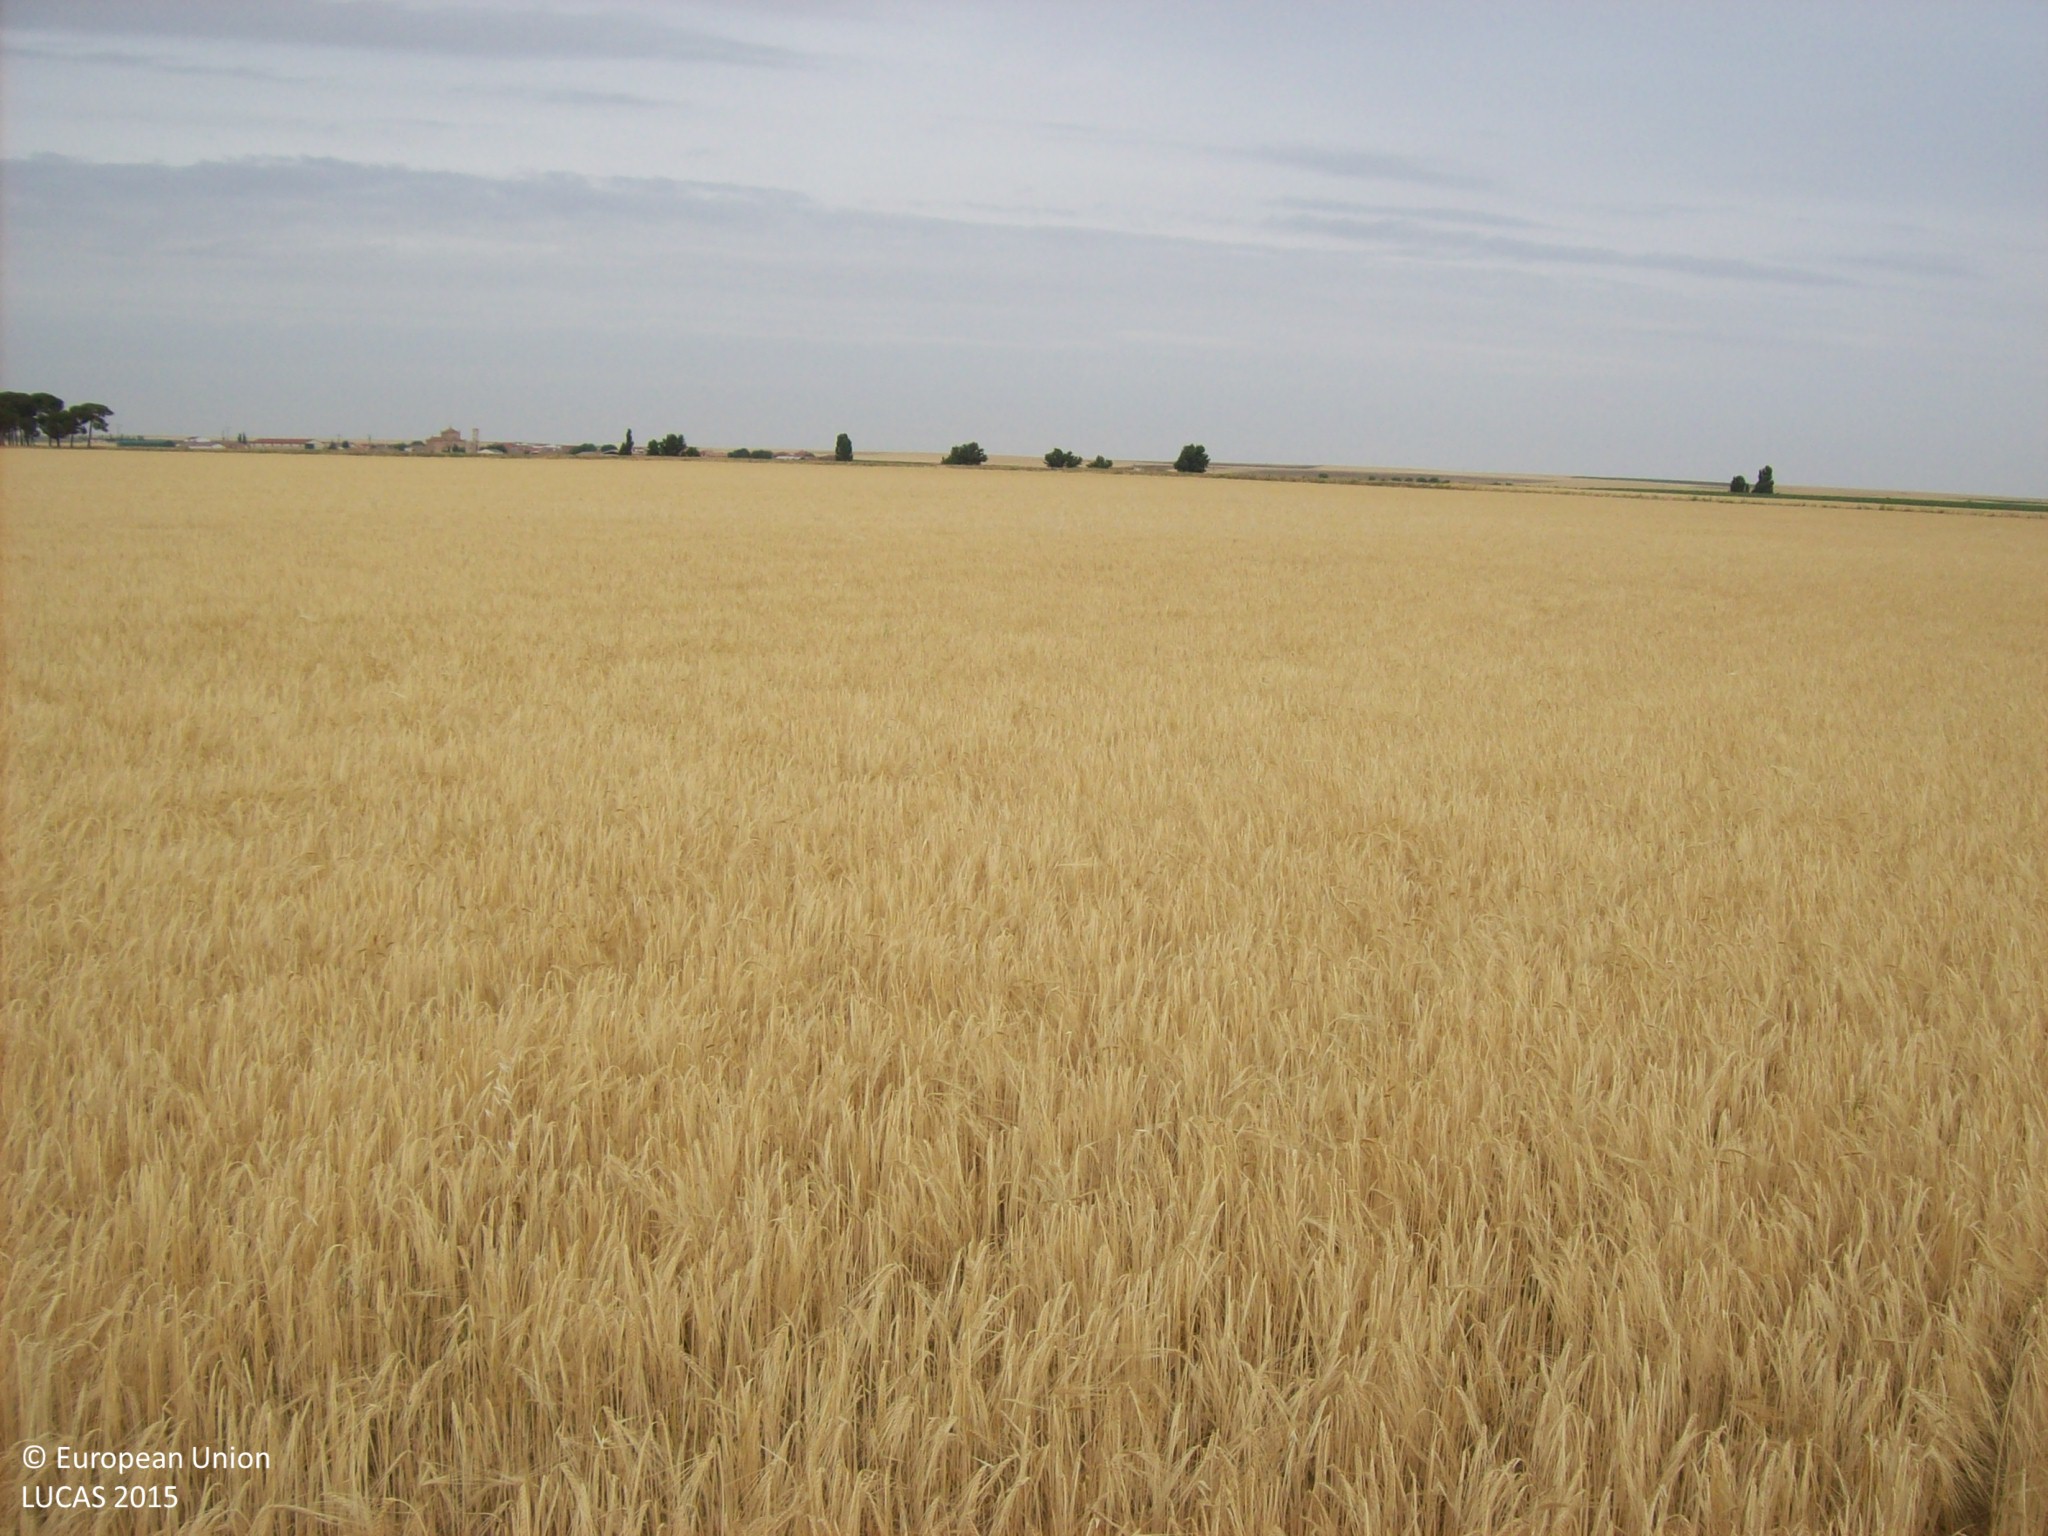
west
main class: Cropland
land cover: Barley
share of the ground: > 75 %
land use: Agriculture (excluding fallow land and kitchen gardens)
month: June
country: ES
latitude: 41.0177
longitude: -4.9895
